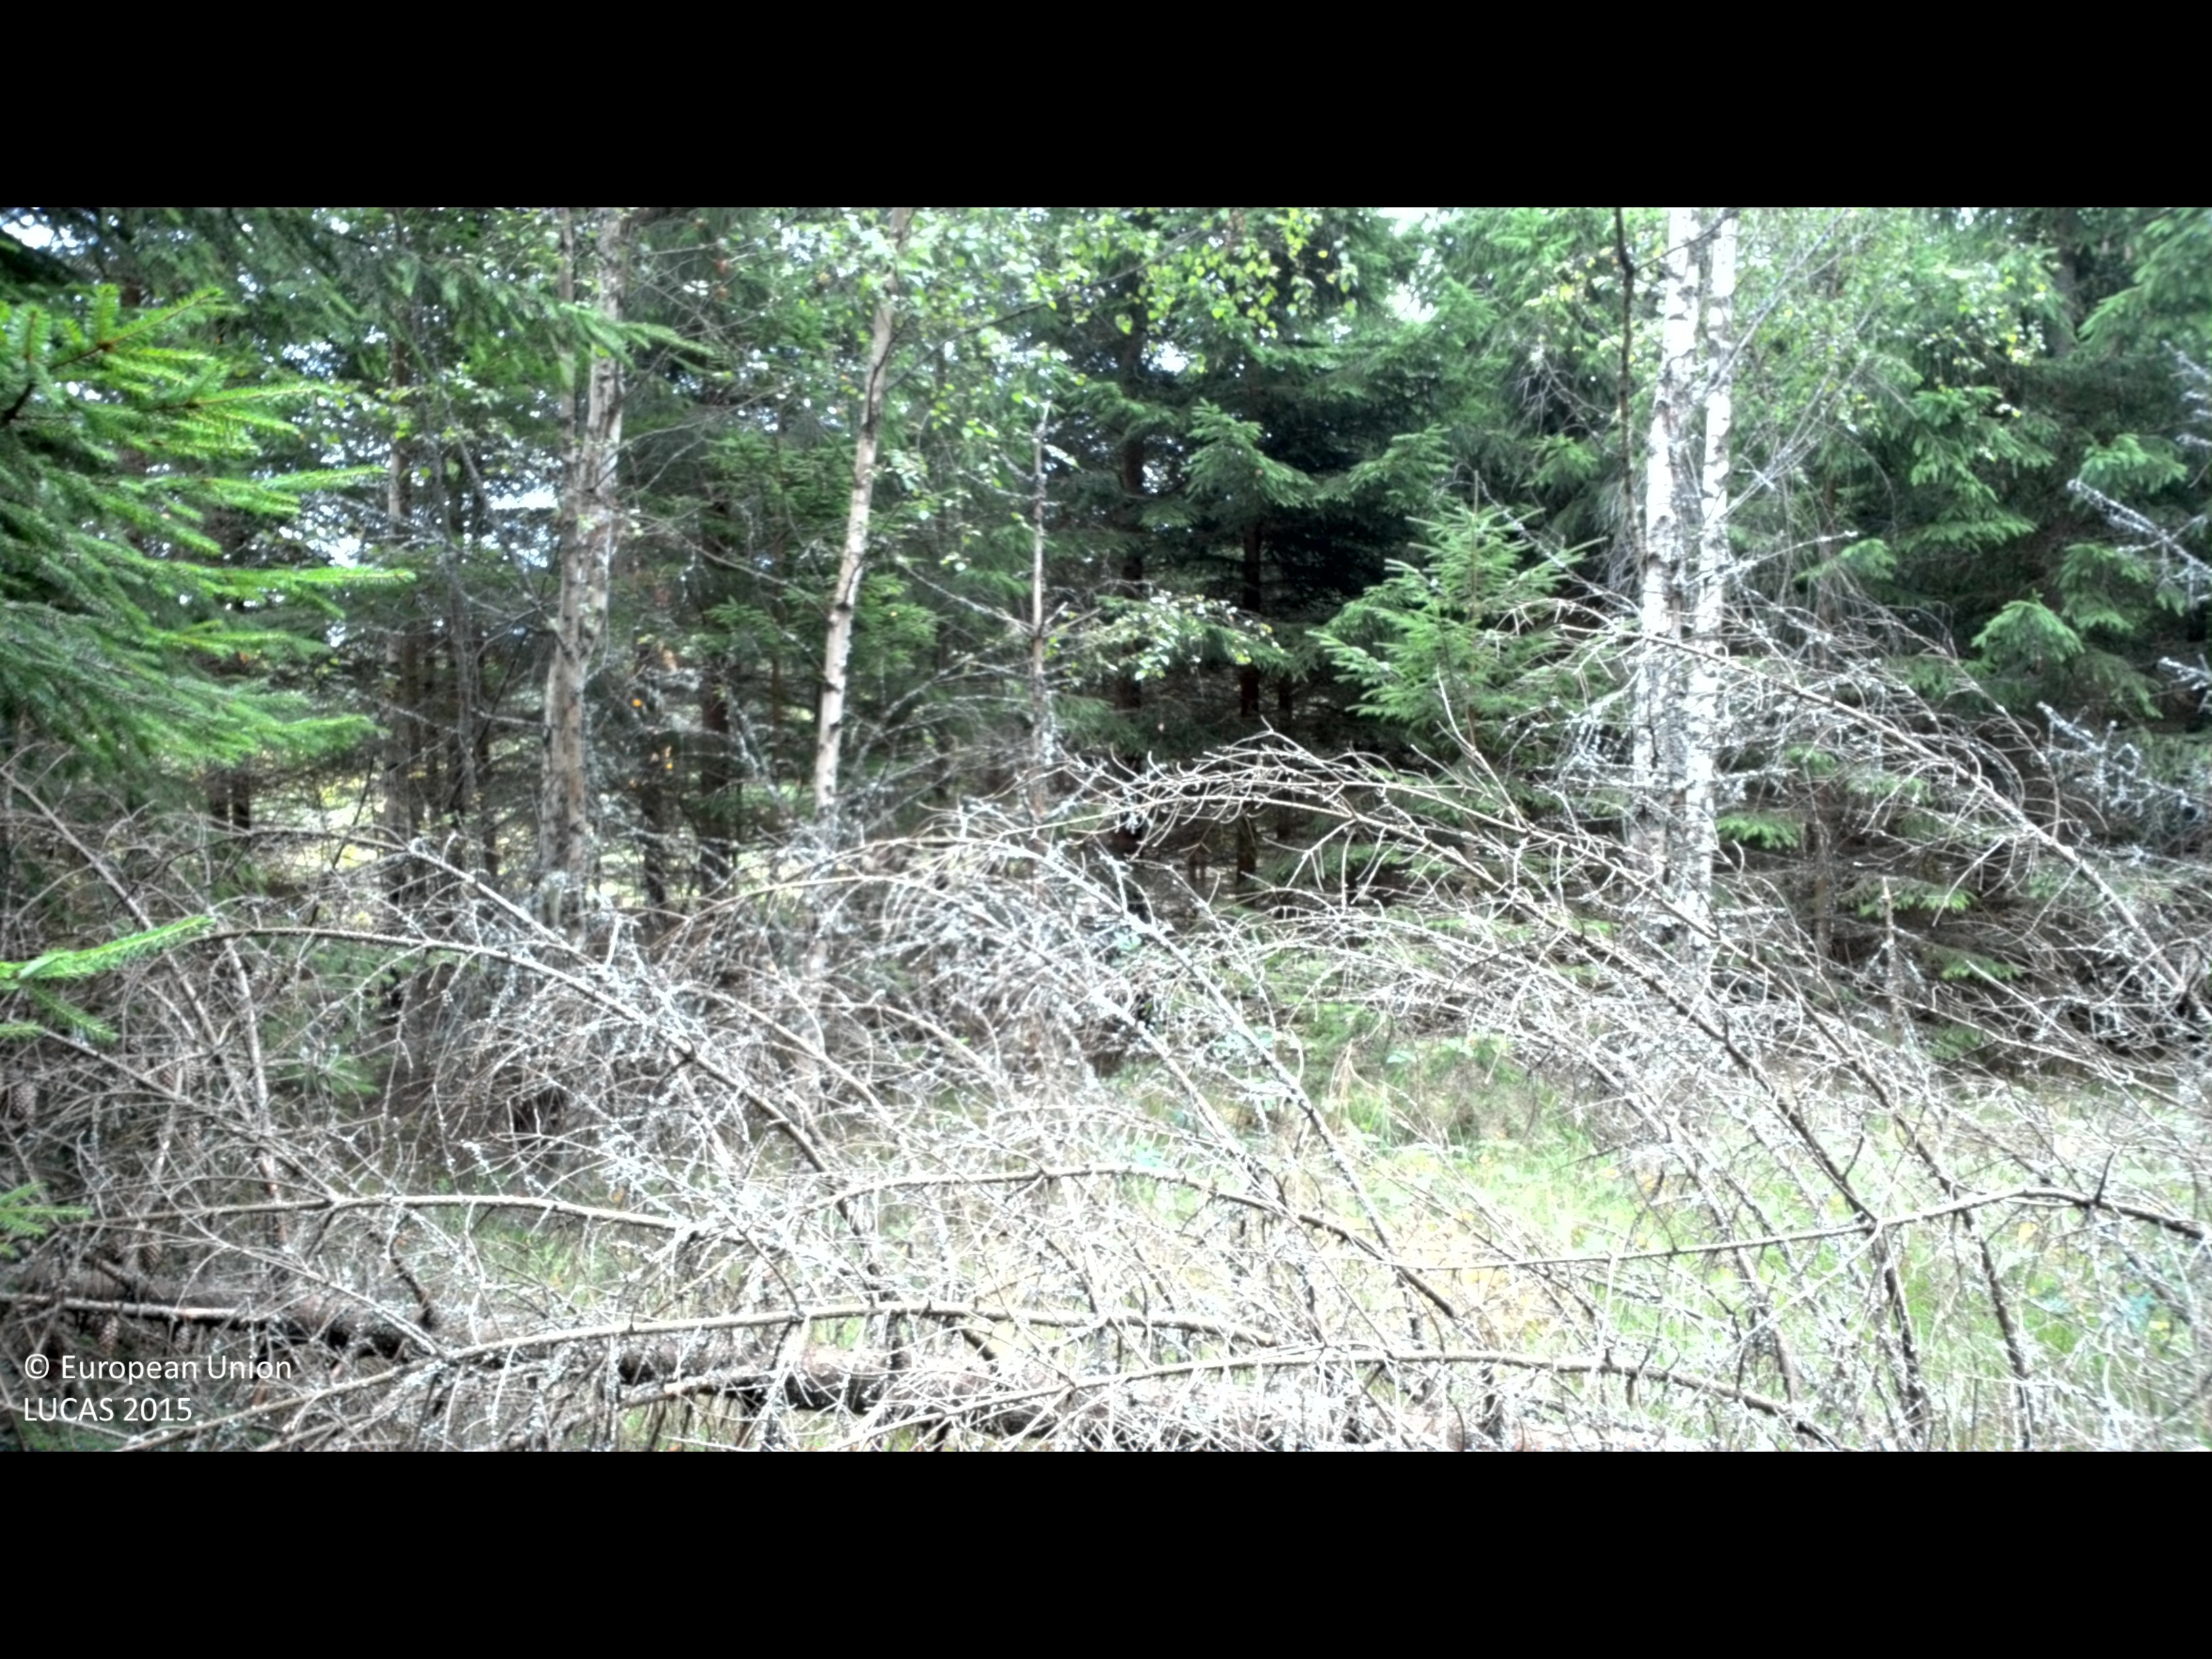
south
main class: Woodland
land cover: Spruce dominated coniferous woodland
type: boreal forest
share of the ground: 50 - 75 %
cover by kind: coniferous forest trees 65 %, lichens and mosses 25 %, broadleaved forest trees 5 %, herbaceous plants 5 %
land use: Forestry
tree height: > 5 m
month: August
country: SE
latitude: 56.3018
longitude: 15.1217
